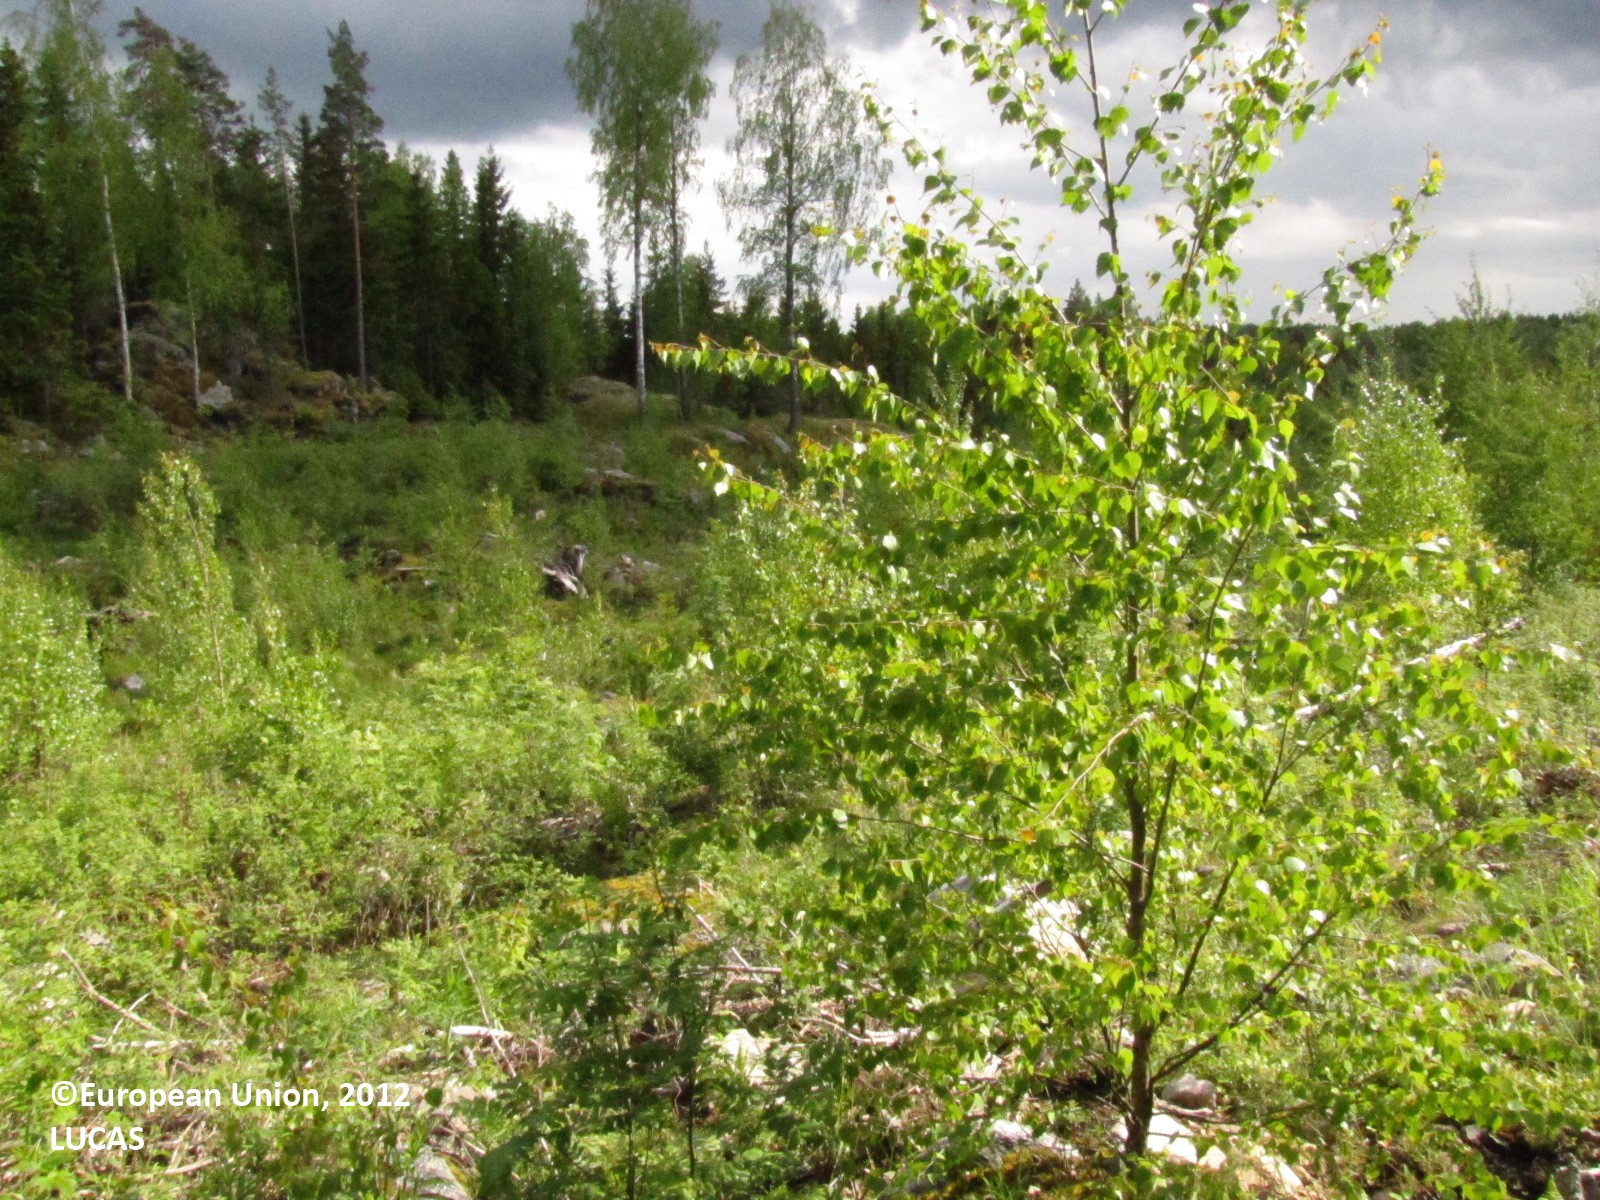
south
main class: Woodland
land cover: Broadleaved woodland
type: hemiboreal forest and nemoral coniferous forest and mixed broadleaved-coniferous forest
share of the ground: 50 - 75 %
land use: Forestry
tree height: < 5 m
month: June
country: FI
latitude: 61.5272
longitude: 23.0648
